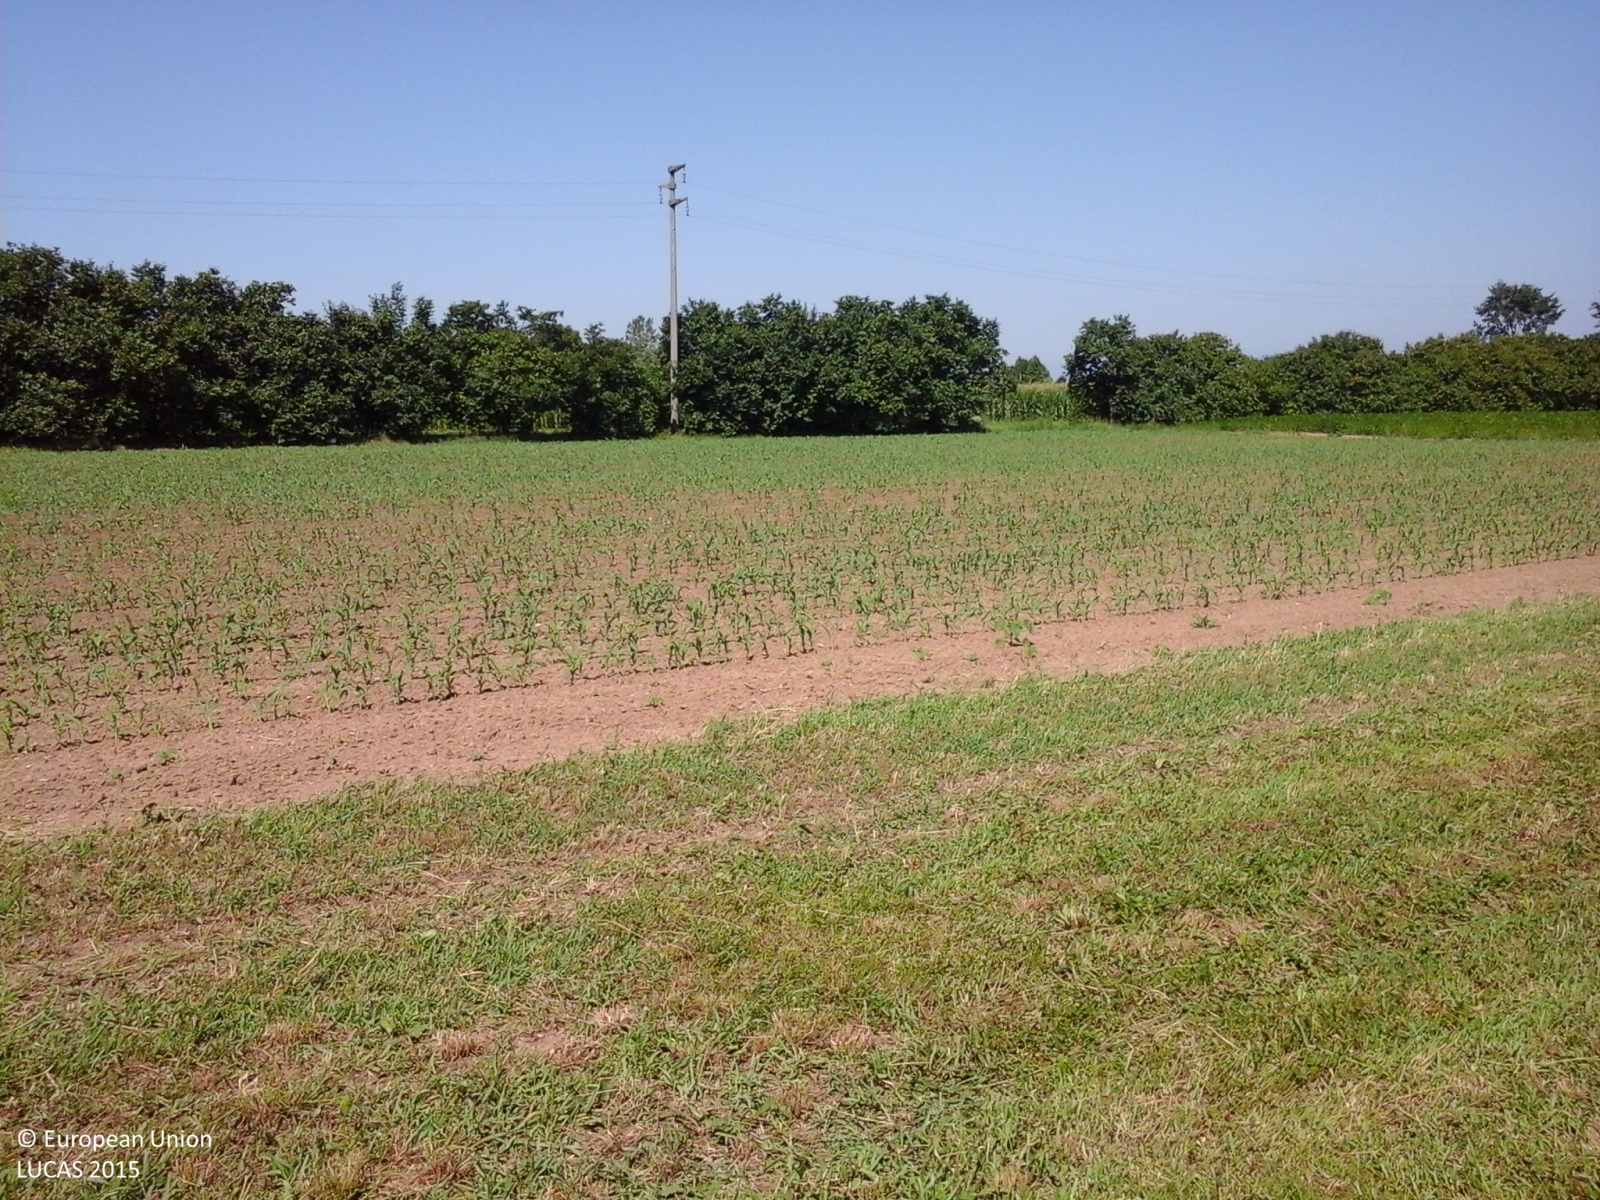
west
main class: Grassland
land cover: Grassland without tree/shrub cover
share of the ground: > 75 %
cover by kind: herbaceous plants 100 %
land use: Agriculture (excluding fallow land and kitchen gardens)
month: July
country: IT
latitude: 45.6772
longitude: 12.3203
